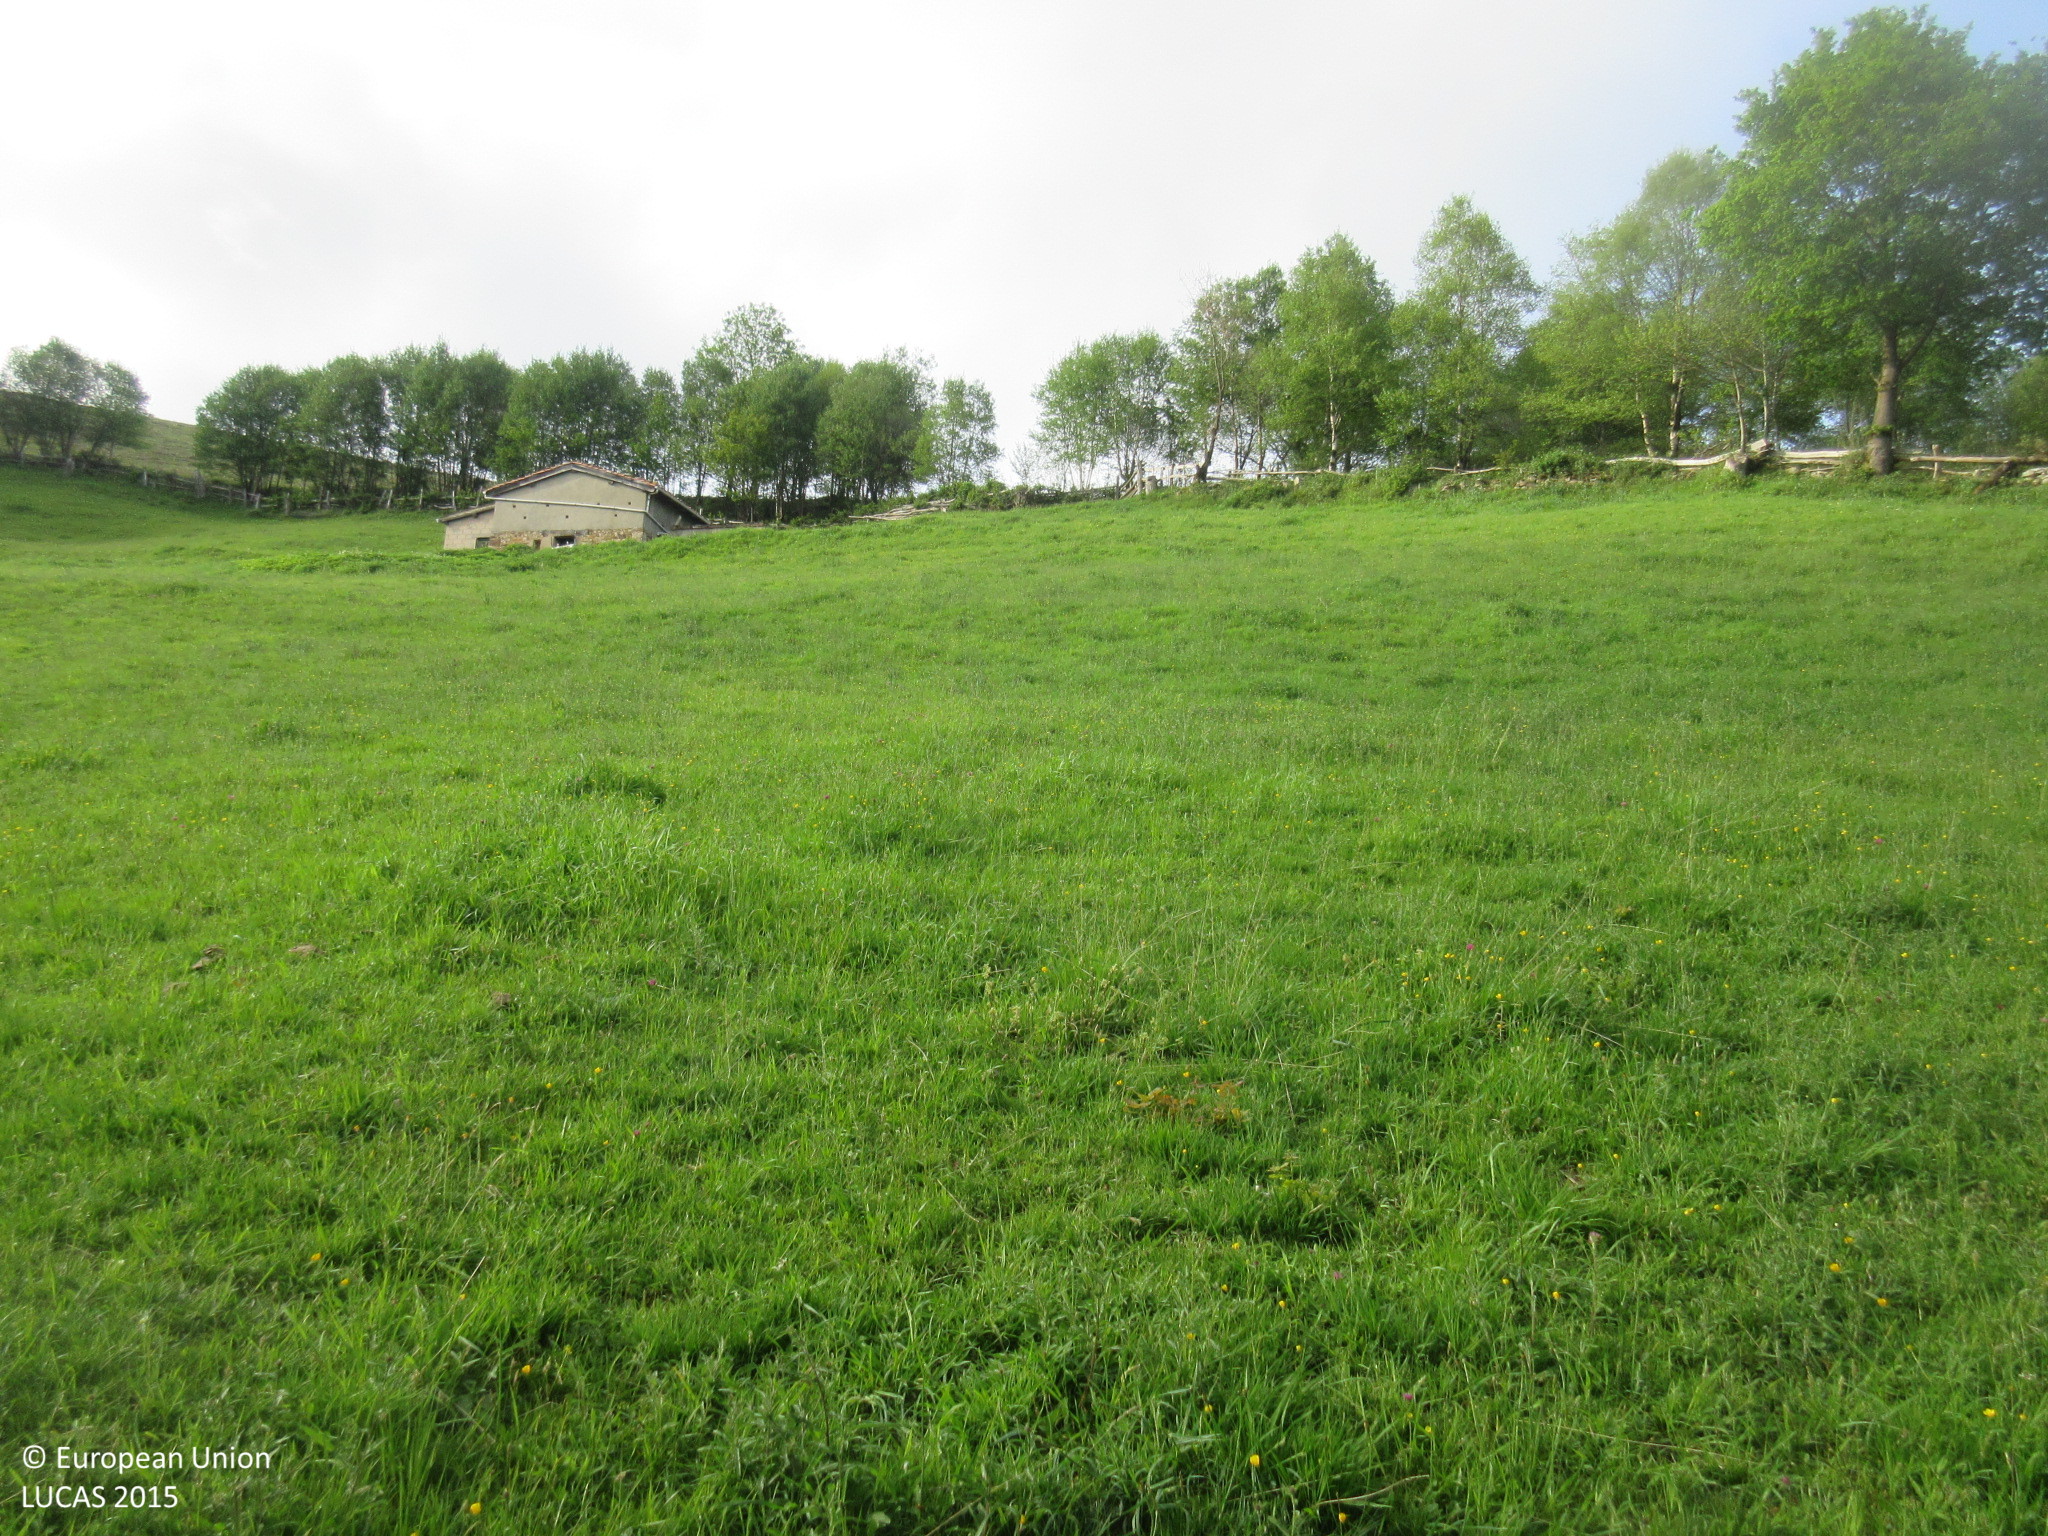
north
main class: Grassland
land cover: Grassland without tree/shrub cover
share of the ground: > 75 %
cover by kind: herbaceous plants 100 %
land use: Agriculture (excluding fallow land and kitchen gardens)
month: May
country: ES
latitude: 43.2455
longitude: -5.8885
